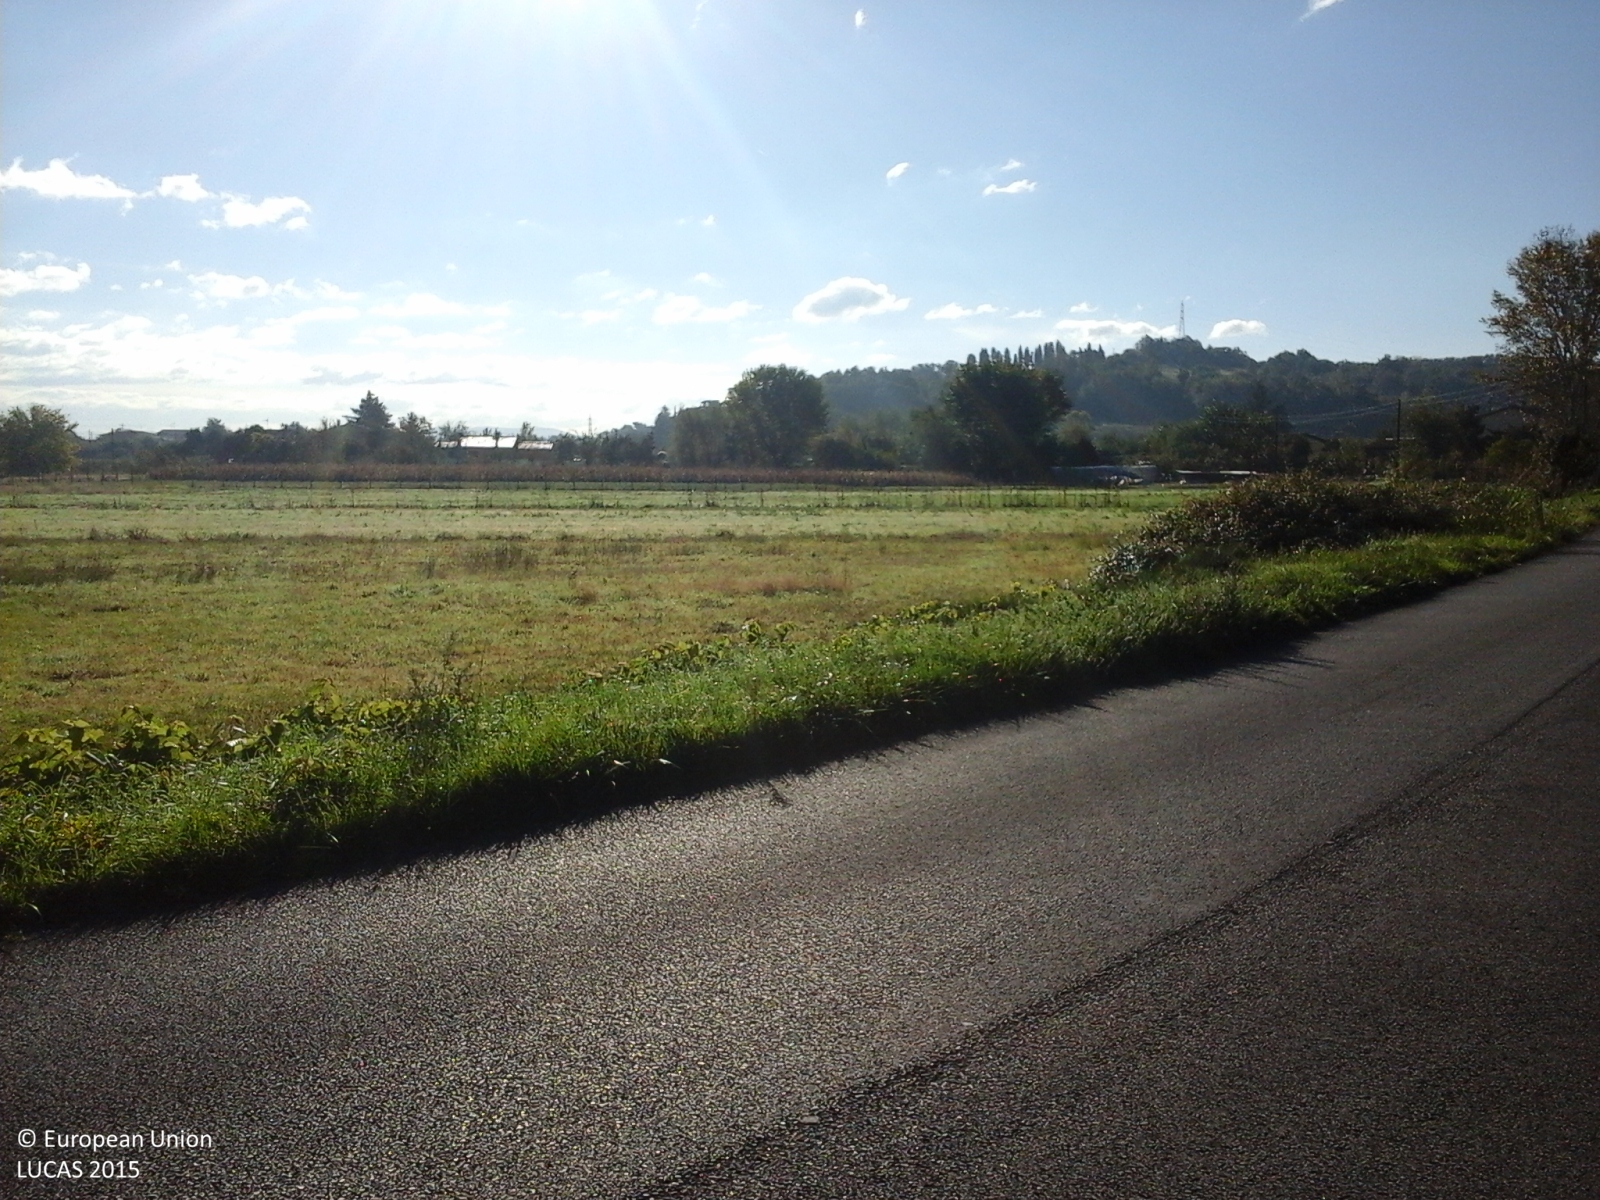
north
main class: Grassland
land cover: Grassland without tree/shrub cover
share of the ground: > 75 %
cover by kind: herbaceous plants 100 %
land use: Agriculture (excluding fallow land and kitchen gardens)
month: October
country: IT
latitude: 43.5451
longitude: 11.5429
